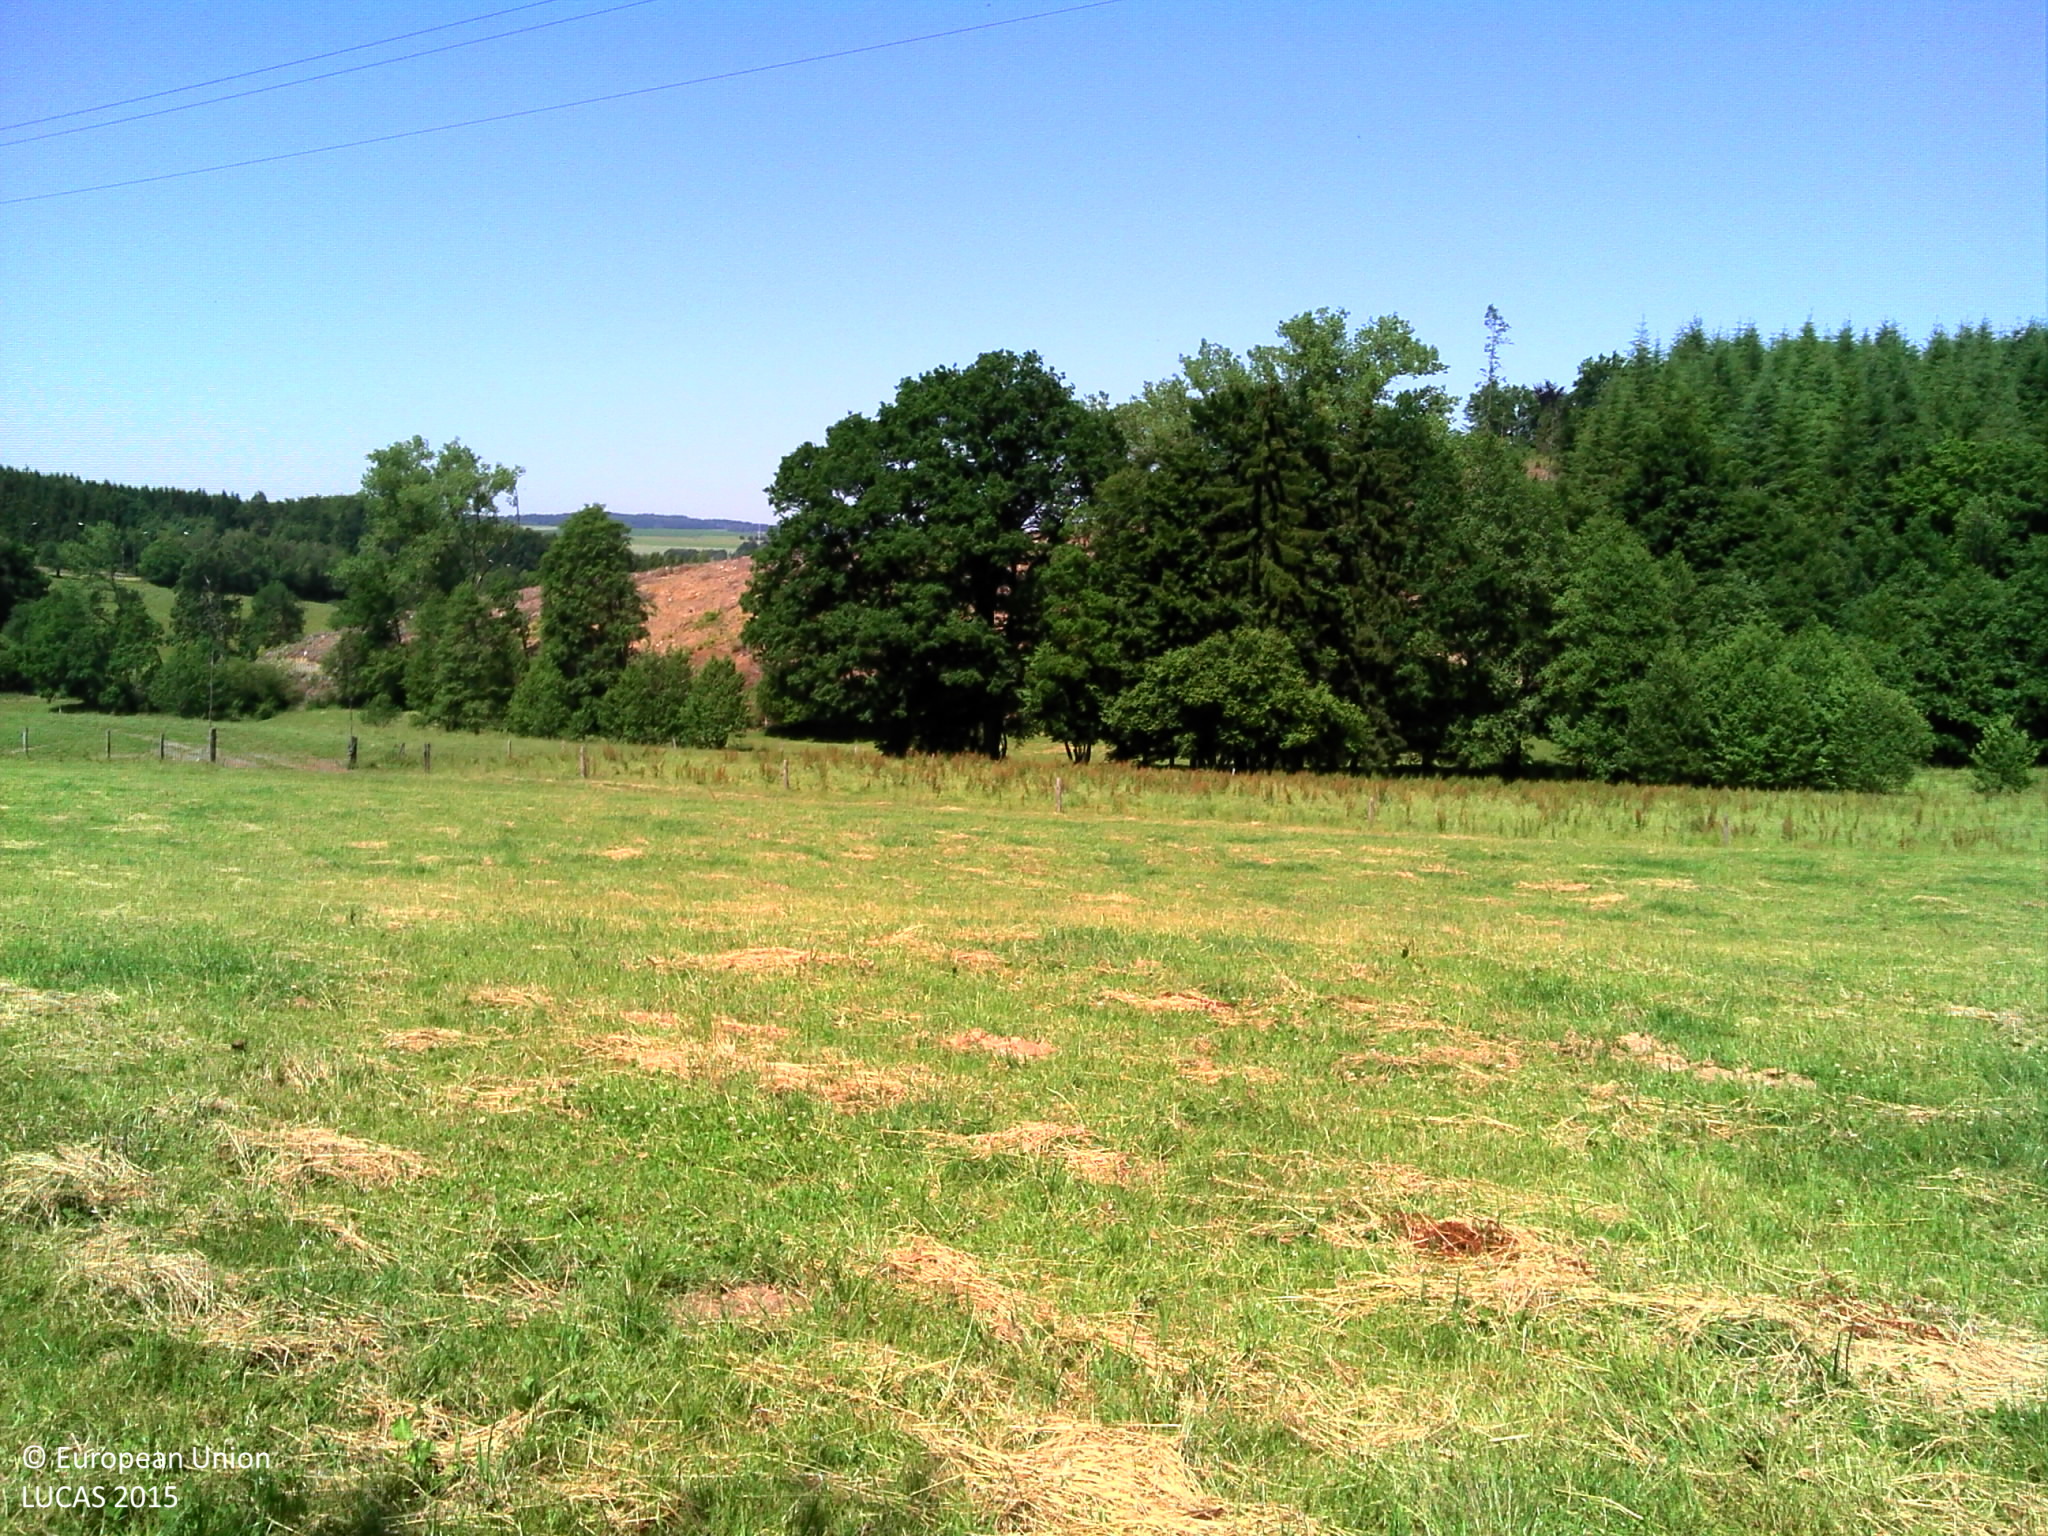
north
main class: Grassland
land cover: Grassland without tree/shrub cover
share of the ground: > 75 %
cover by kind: herbaceous plants 100 %
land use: Agriculture (excluding fallow land and kitchen gardens)
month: June
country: BE
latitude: 50.0611
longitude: 5.5423
